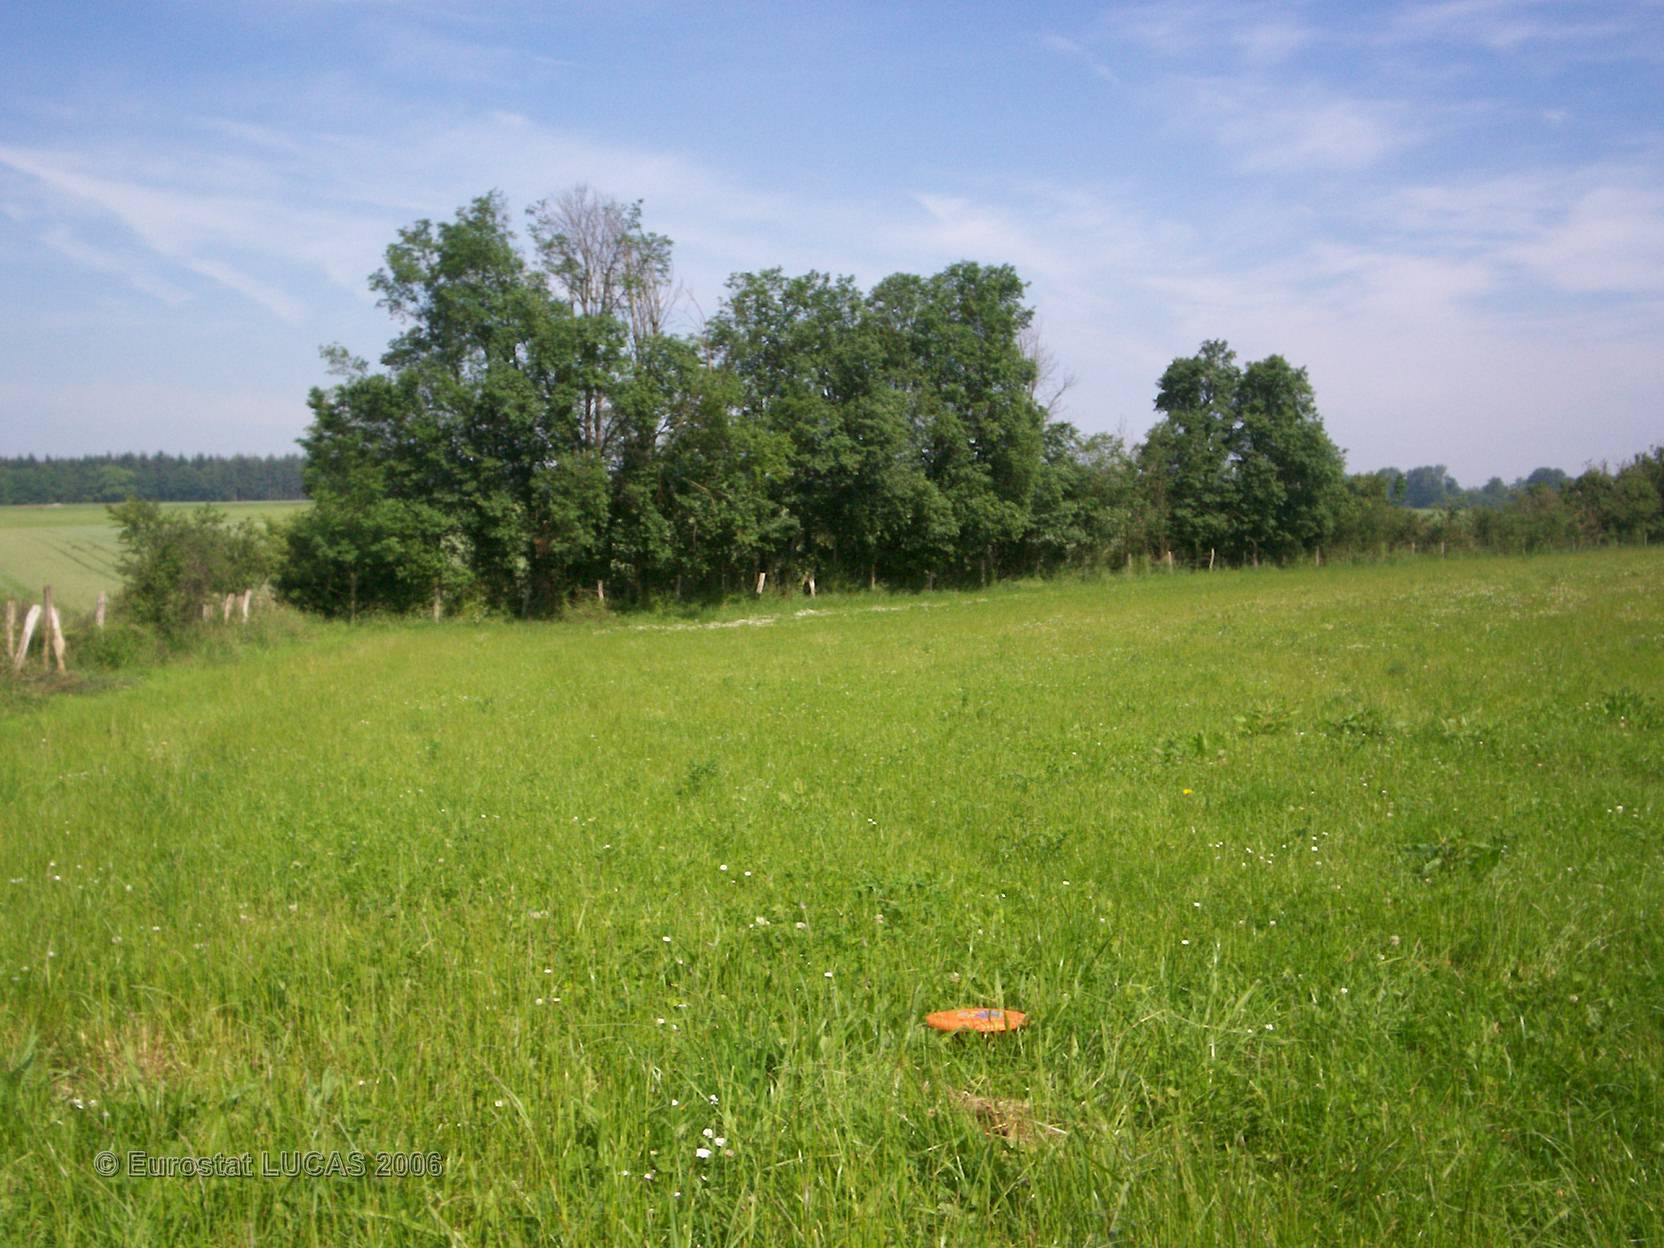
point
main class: Grassland
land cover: Grassland without tree/shrub cover
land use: Agriculture (excluding fallow land and kitchen gardens)
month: June
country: FR
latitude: 49.5710
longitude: 2.7016
